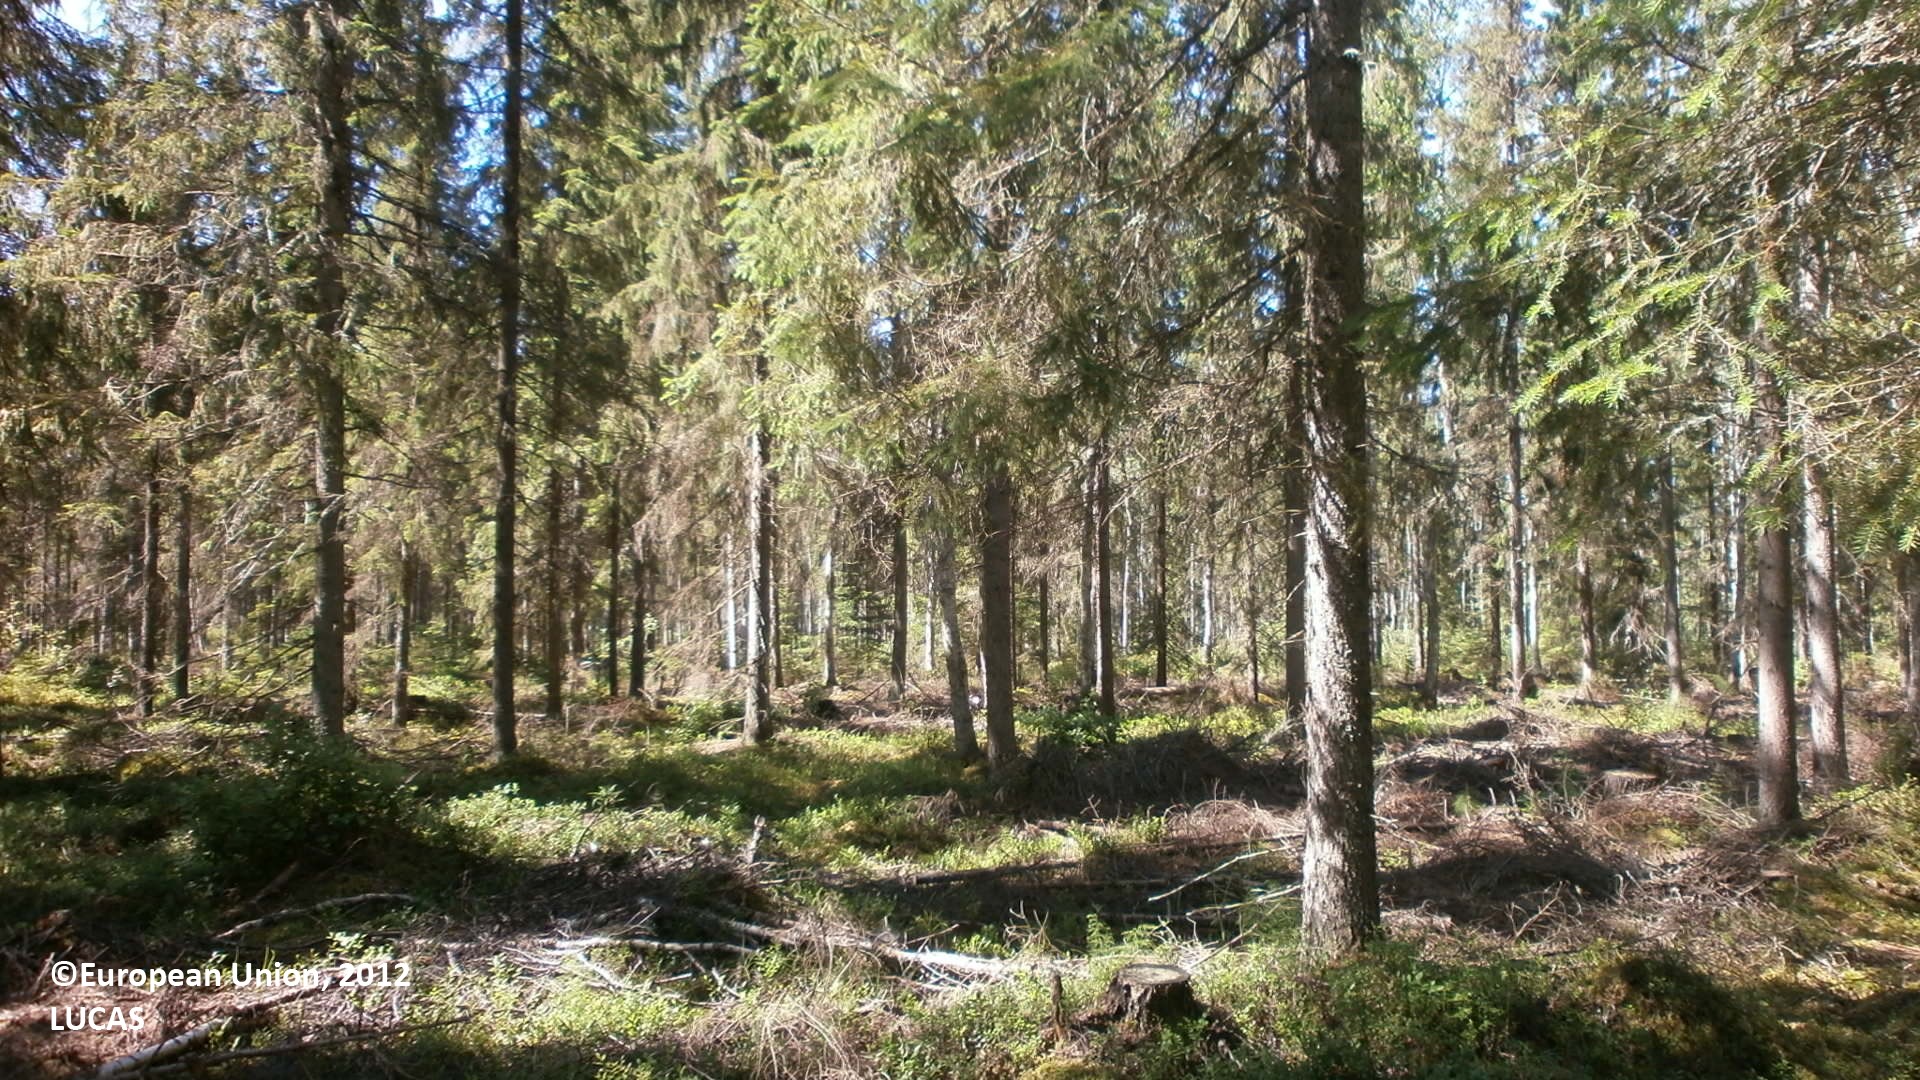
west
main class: Woodland
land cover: Spruce dominated coniferous woodland
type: boreal forest
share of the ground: 50 - 75 %
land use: Forestry
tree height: > 5 m
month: July
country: FI
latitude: 64.3515
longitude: 24.1234
